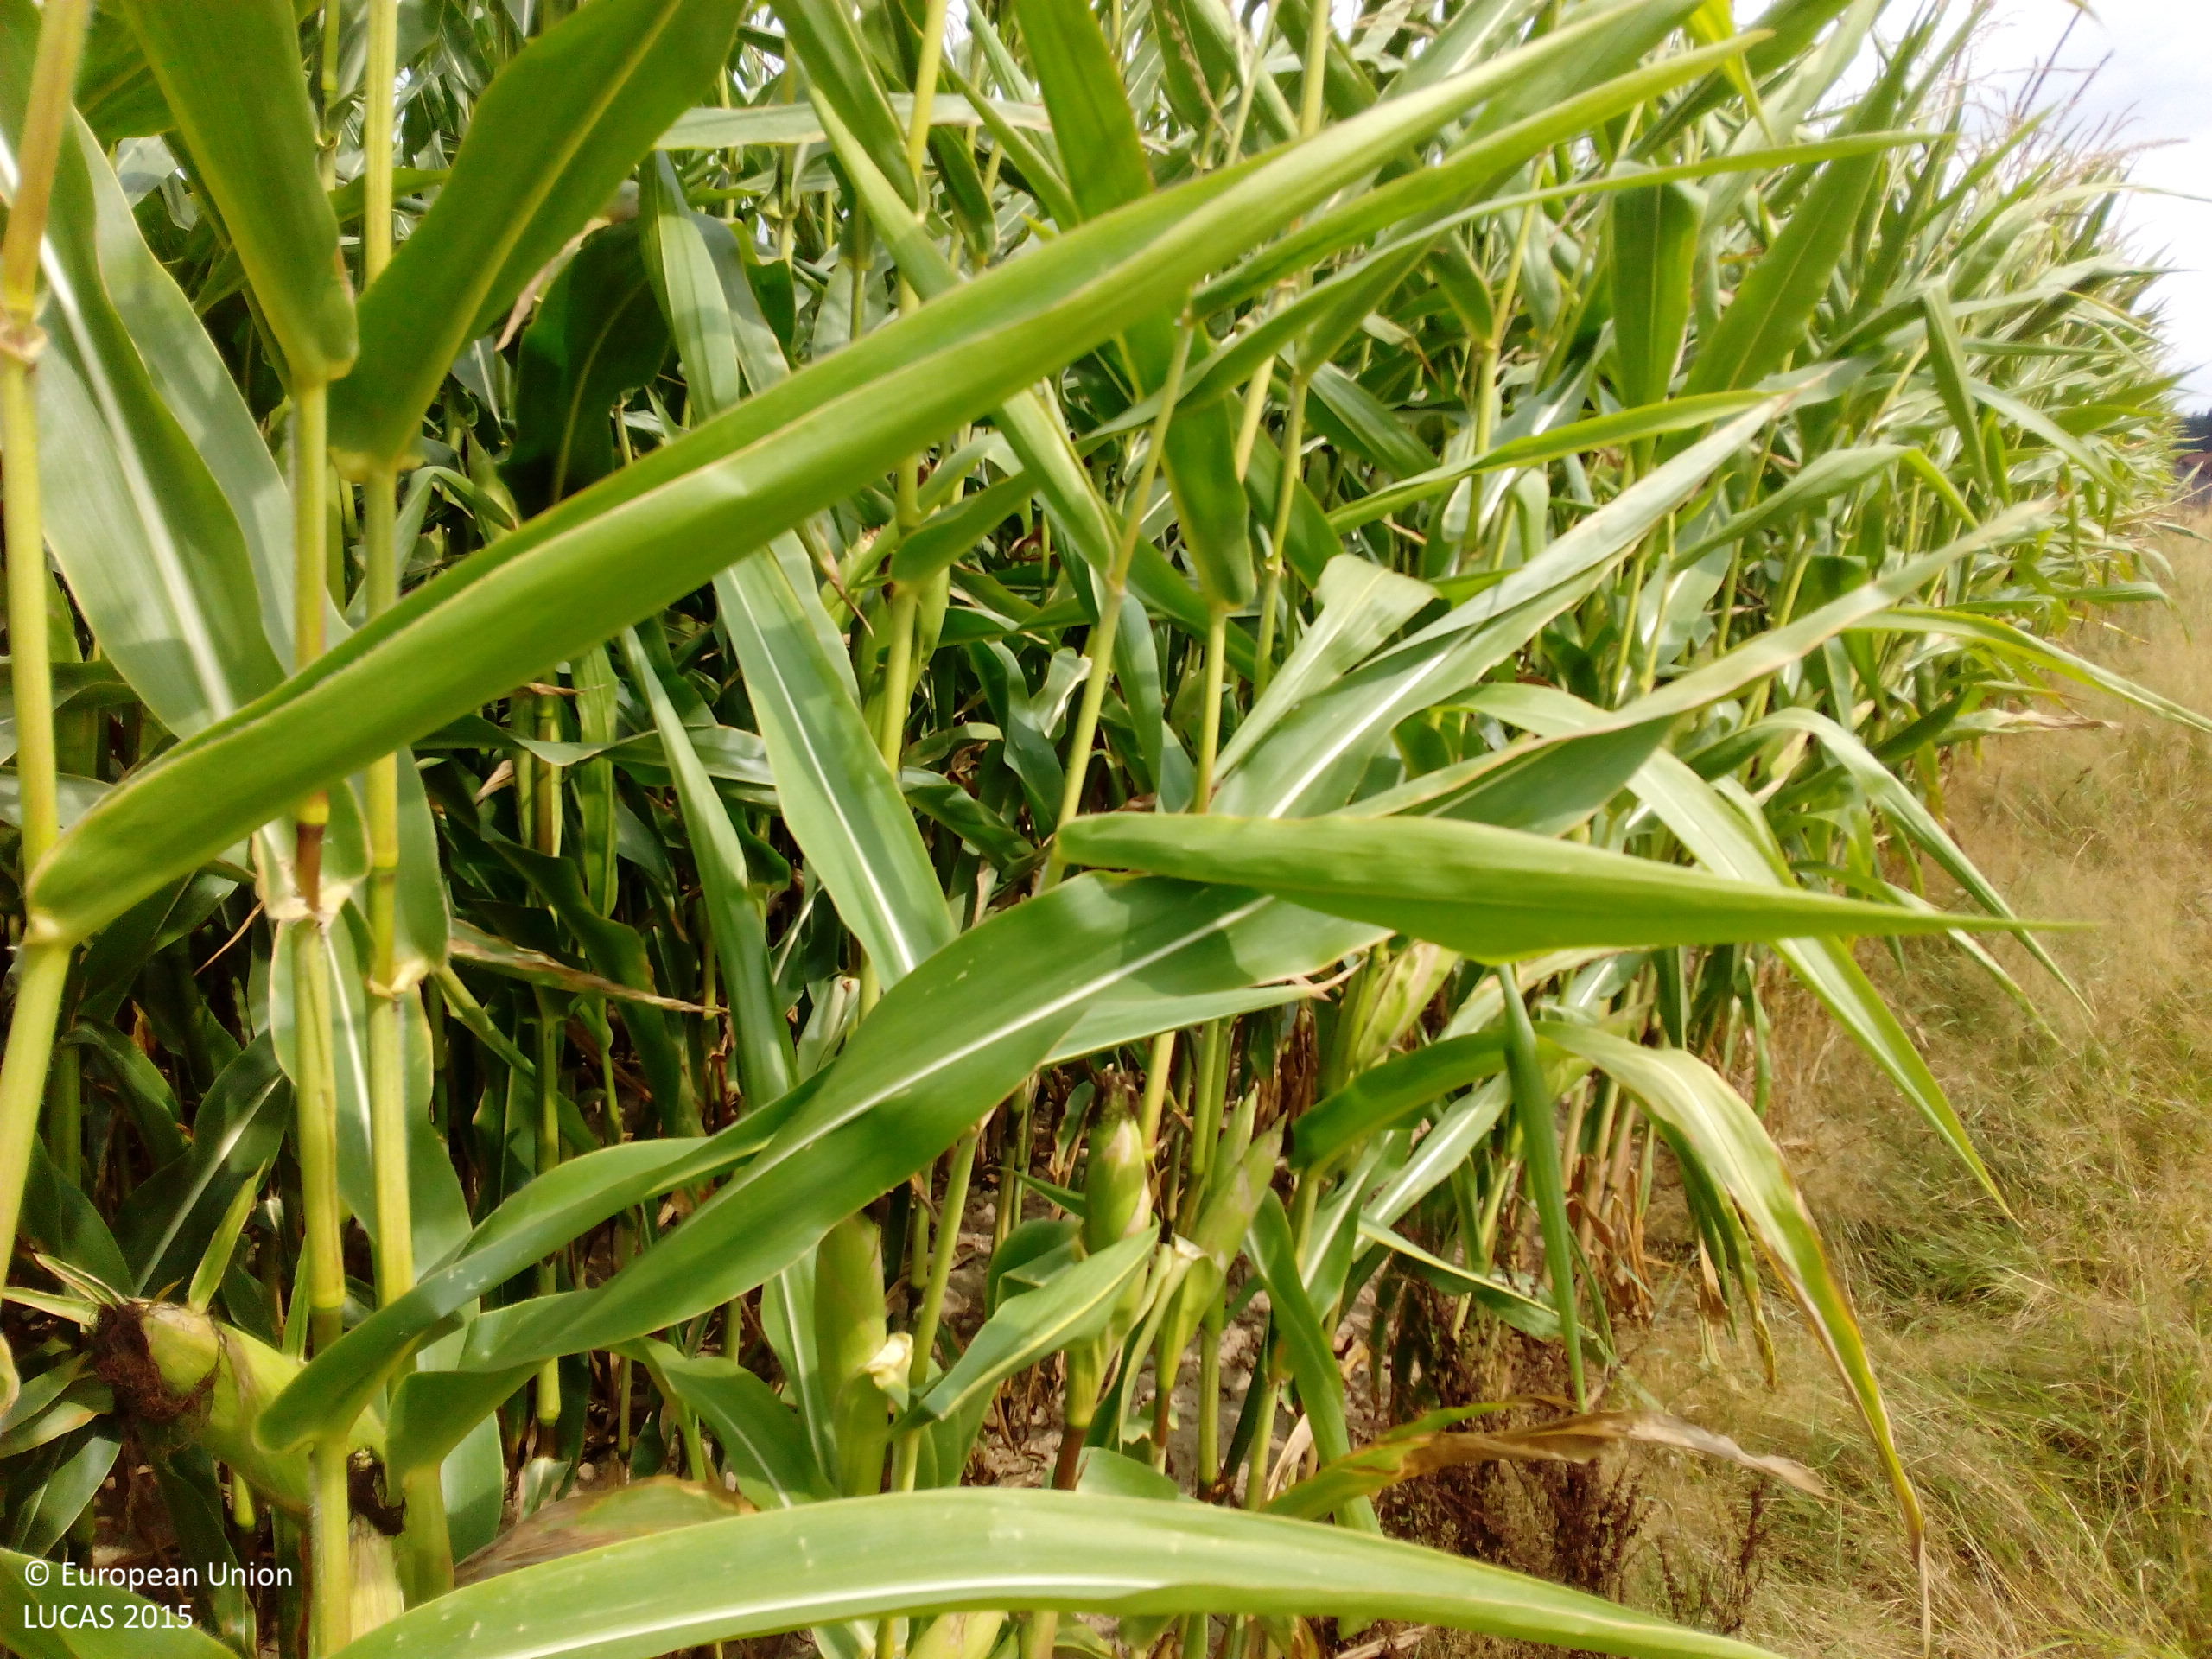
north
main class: Cropland
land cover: Maize
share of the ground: > 75 %
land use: Agriculture (excluding fallow land and kitchen gardens)
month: August
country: DE
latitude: 48.7511
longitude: 13.2774
